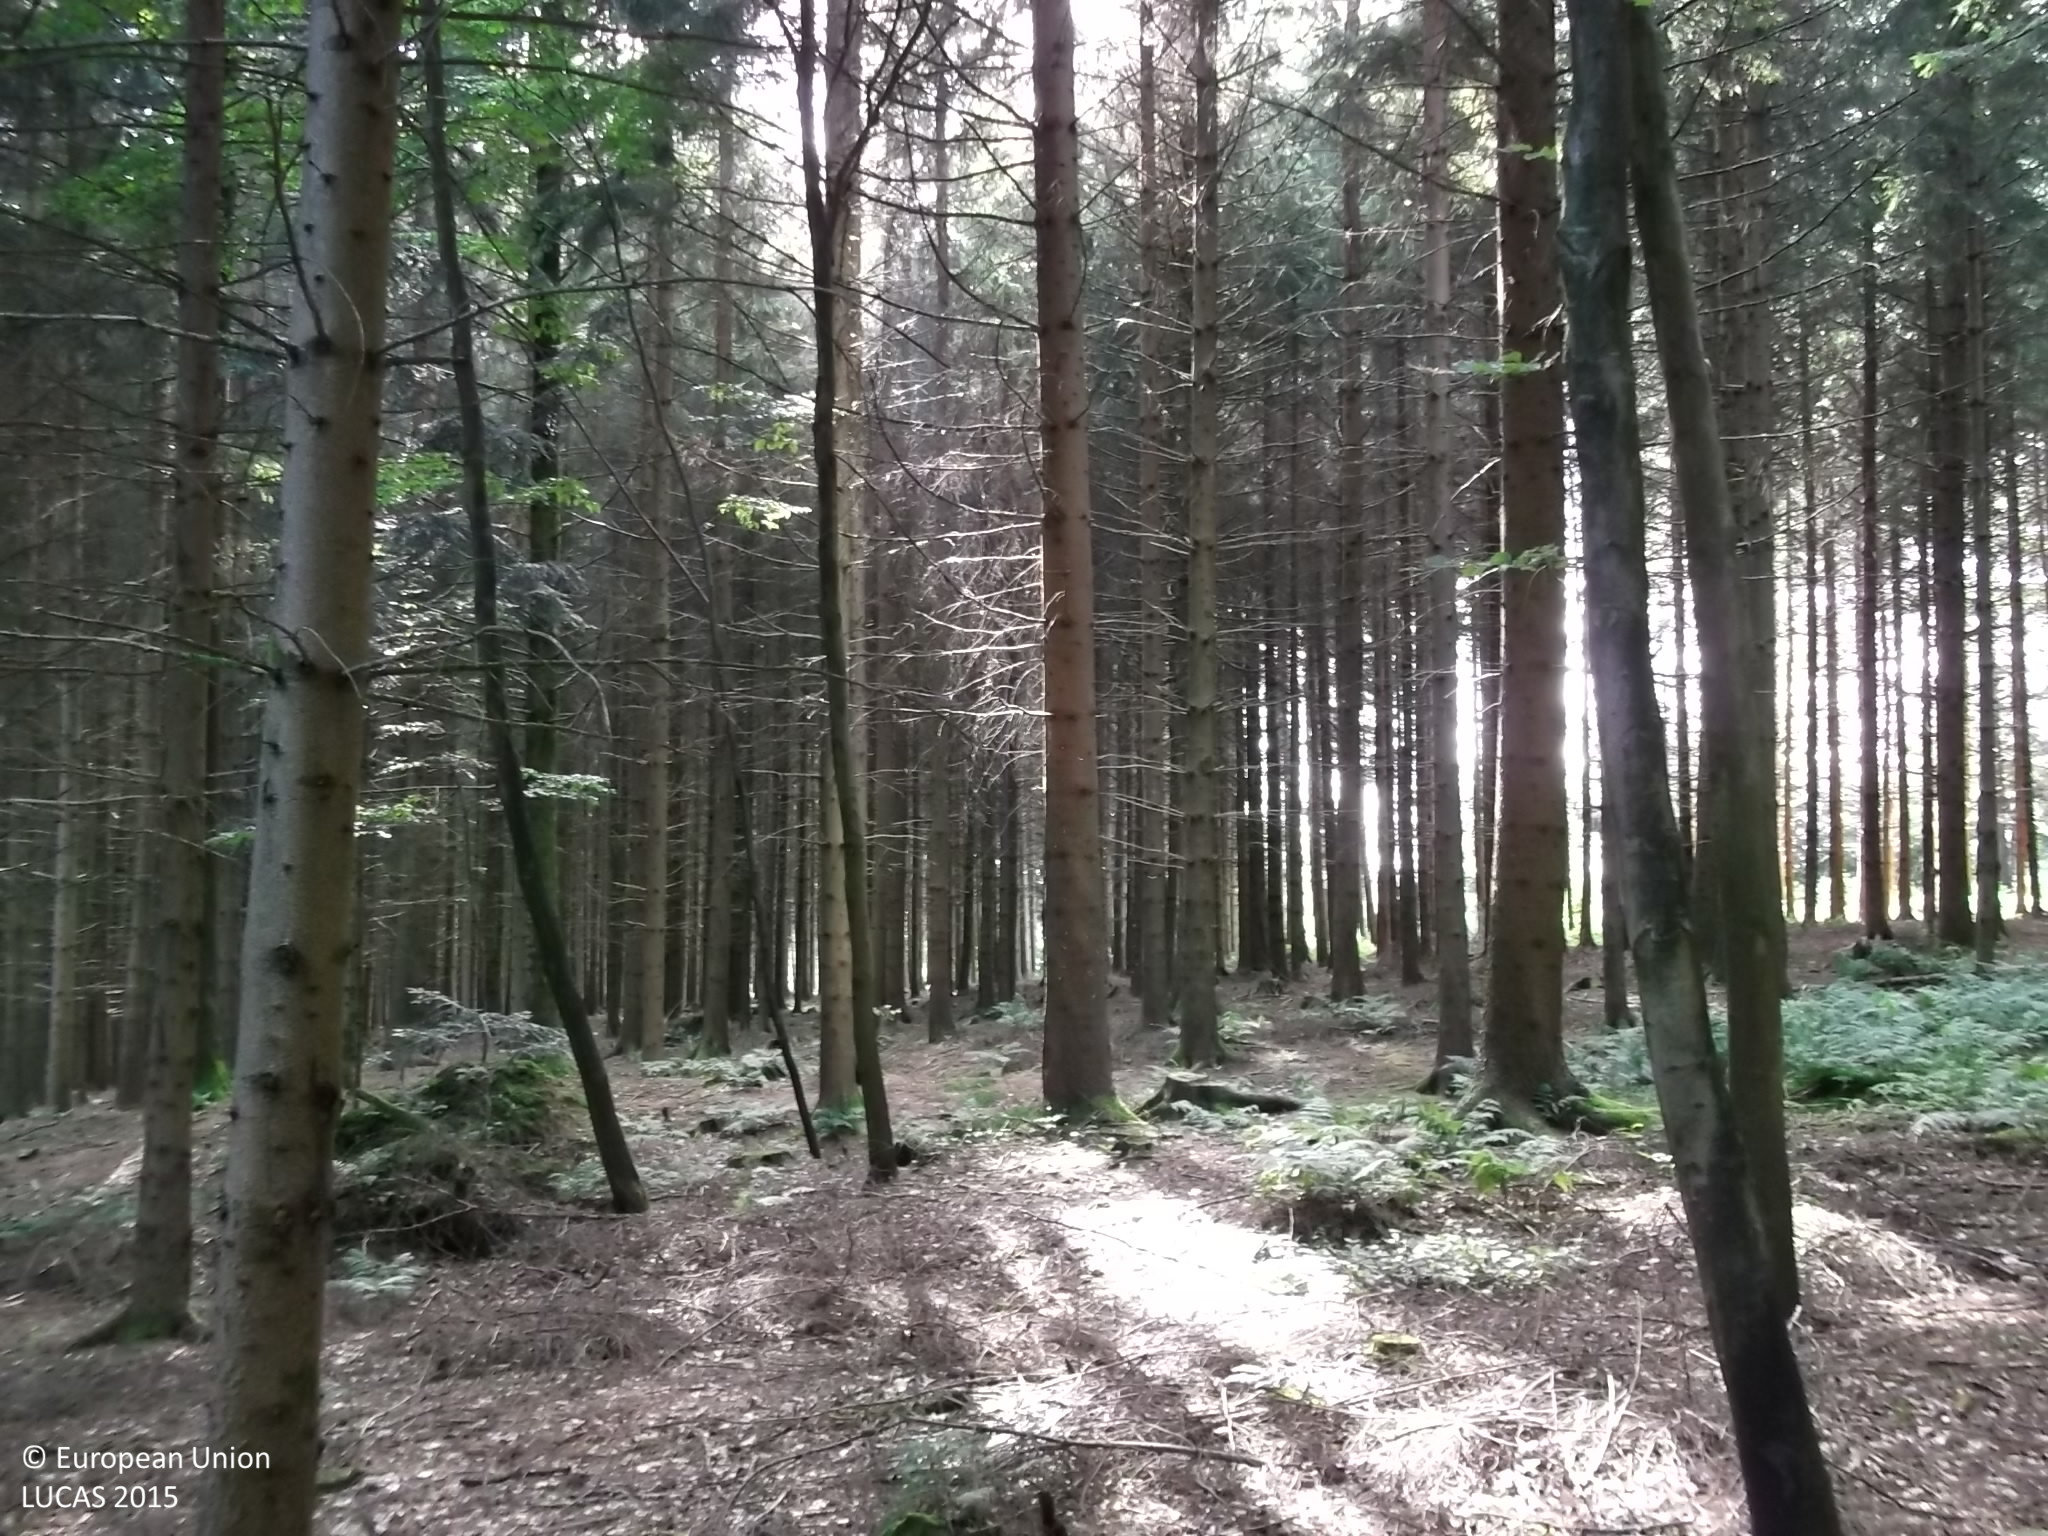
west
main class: Woodland
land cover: Spruce dominated mixed woodland
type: hemiboreal forest and nemoral coniferous forest and mixed broadleaved-coniferous forest
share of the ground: > 75 %
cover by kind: coniferous forest trees 65 %, broadleaved forest trees 30 %, herbaceous plants 5 %
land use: Forestry
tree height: > 5 m
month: June
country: AT
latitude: 47.9914
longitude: 13.3893
